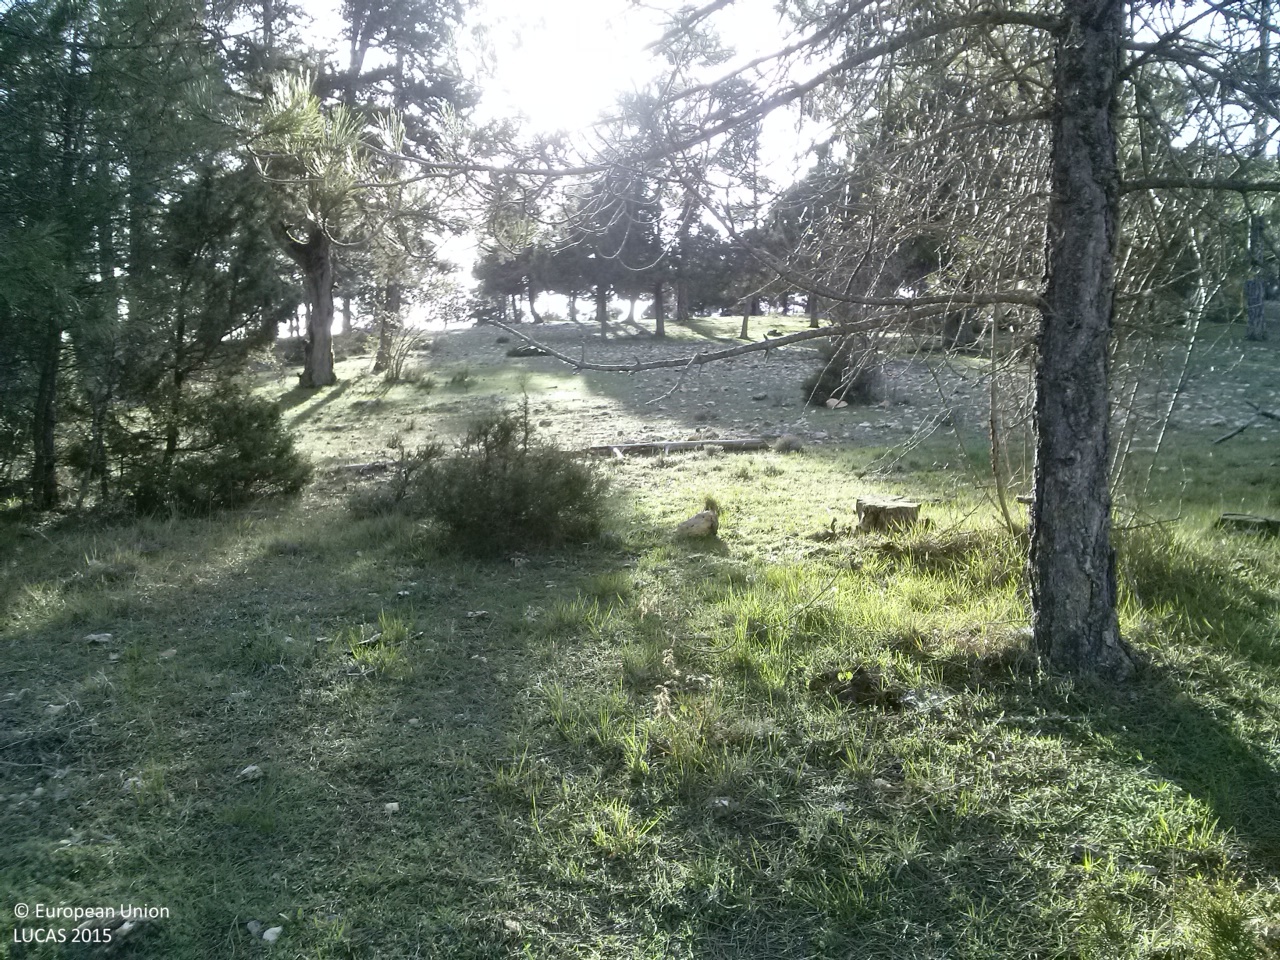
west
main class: Woodland
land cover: Pine dominated coniferous woodland
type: coniferous forest of the mediterranean region
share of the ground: 25 - 50 %
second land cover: Grassland without tree/shrub cover
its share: > 75 %
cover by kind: herbaceous plants 60 %, coniferous forest trees 35 %, shrubs 5 %
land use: Forestry
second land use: Agriculture (excluding fallow land and kitchen gardens)
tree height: > 5 m
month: April
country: ES
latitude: 40.1576
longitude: -1.9314
